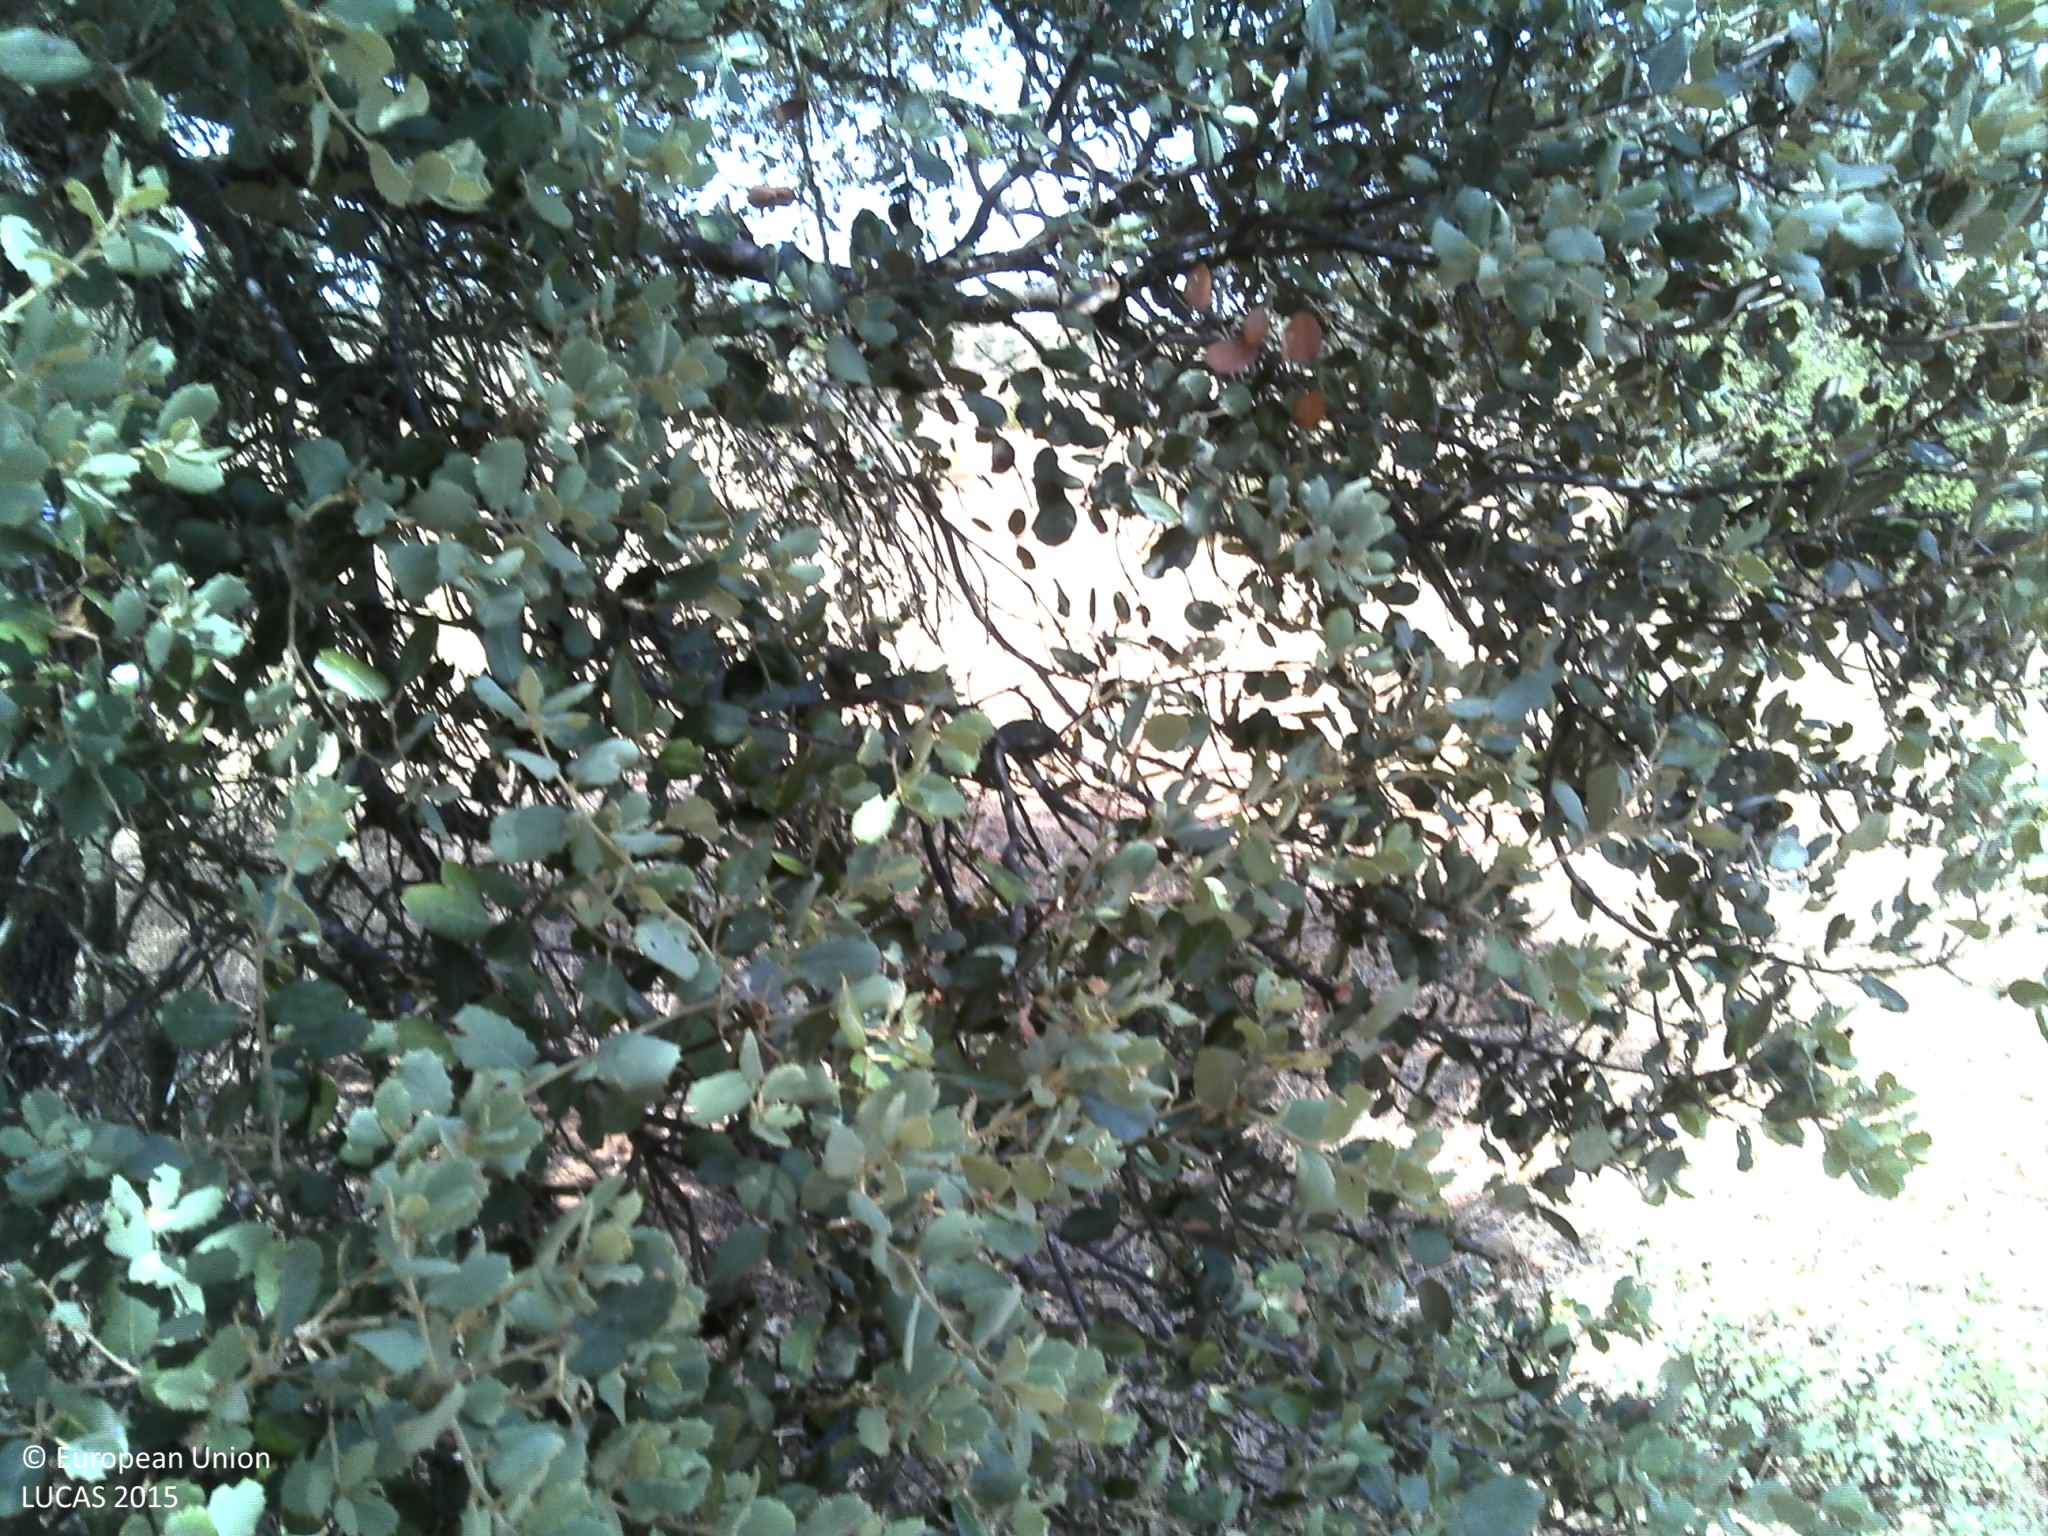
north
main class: Woodland
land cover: Broadleaved woodland
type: broadleaved evergreen forest
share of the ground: 10 - 25 %
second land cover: Grassland without tree/shrub cover
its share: 10 - 25 %
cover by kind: unconsolidated bare surface 55 %, herbaceous plants 25 %, broadleaved forest trees 10 %, shrubs 5 %
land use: Forestry
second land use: Agriculture (excluding fallow land and kitchen gardens)
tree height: > 5 m
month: July
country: PT
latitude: 37.7236
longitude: -7.7755
